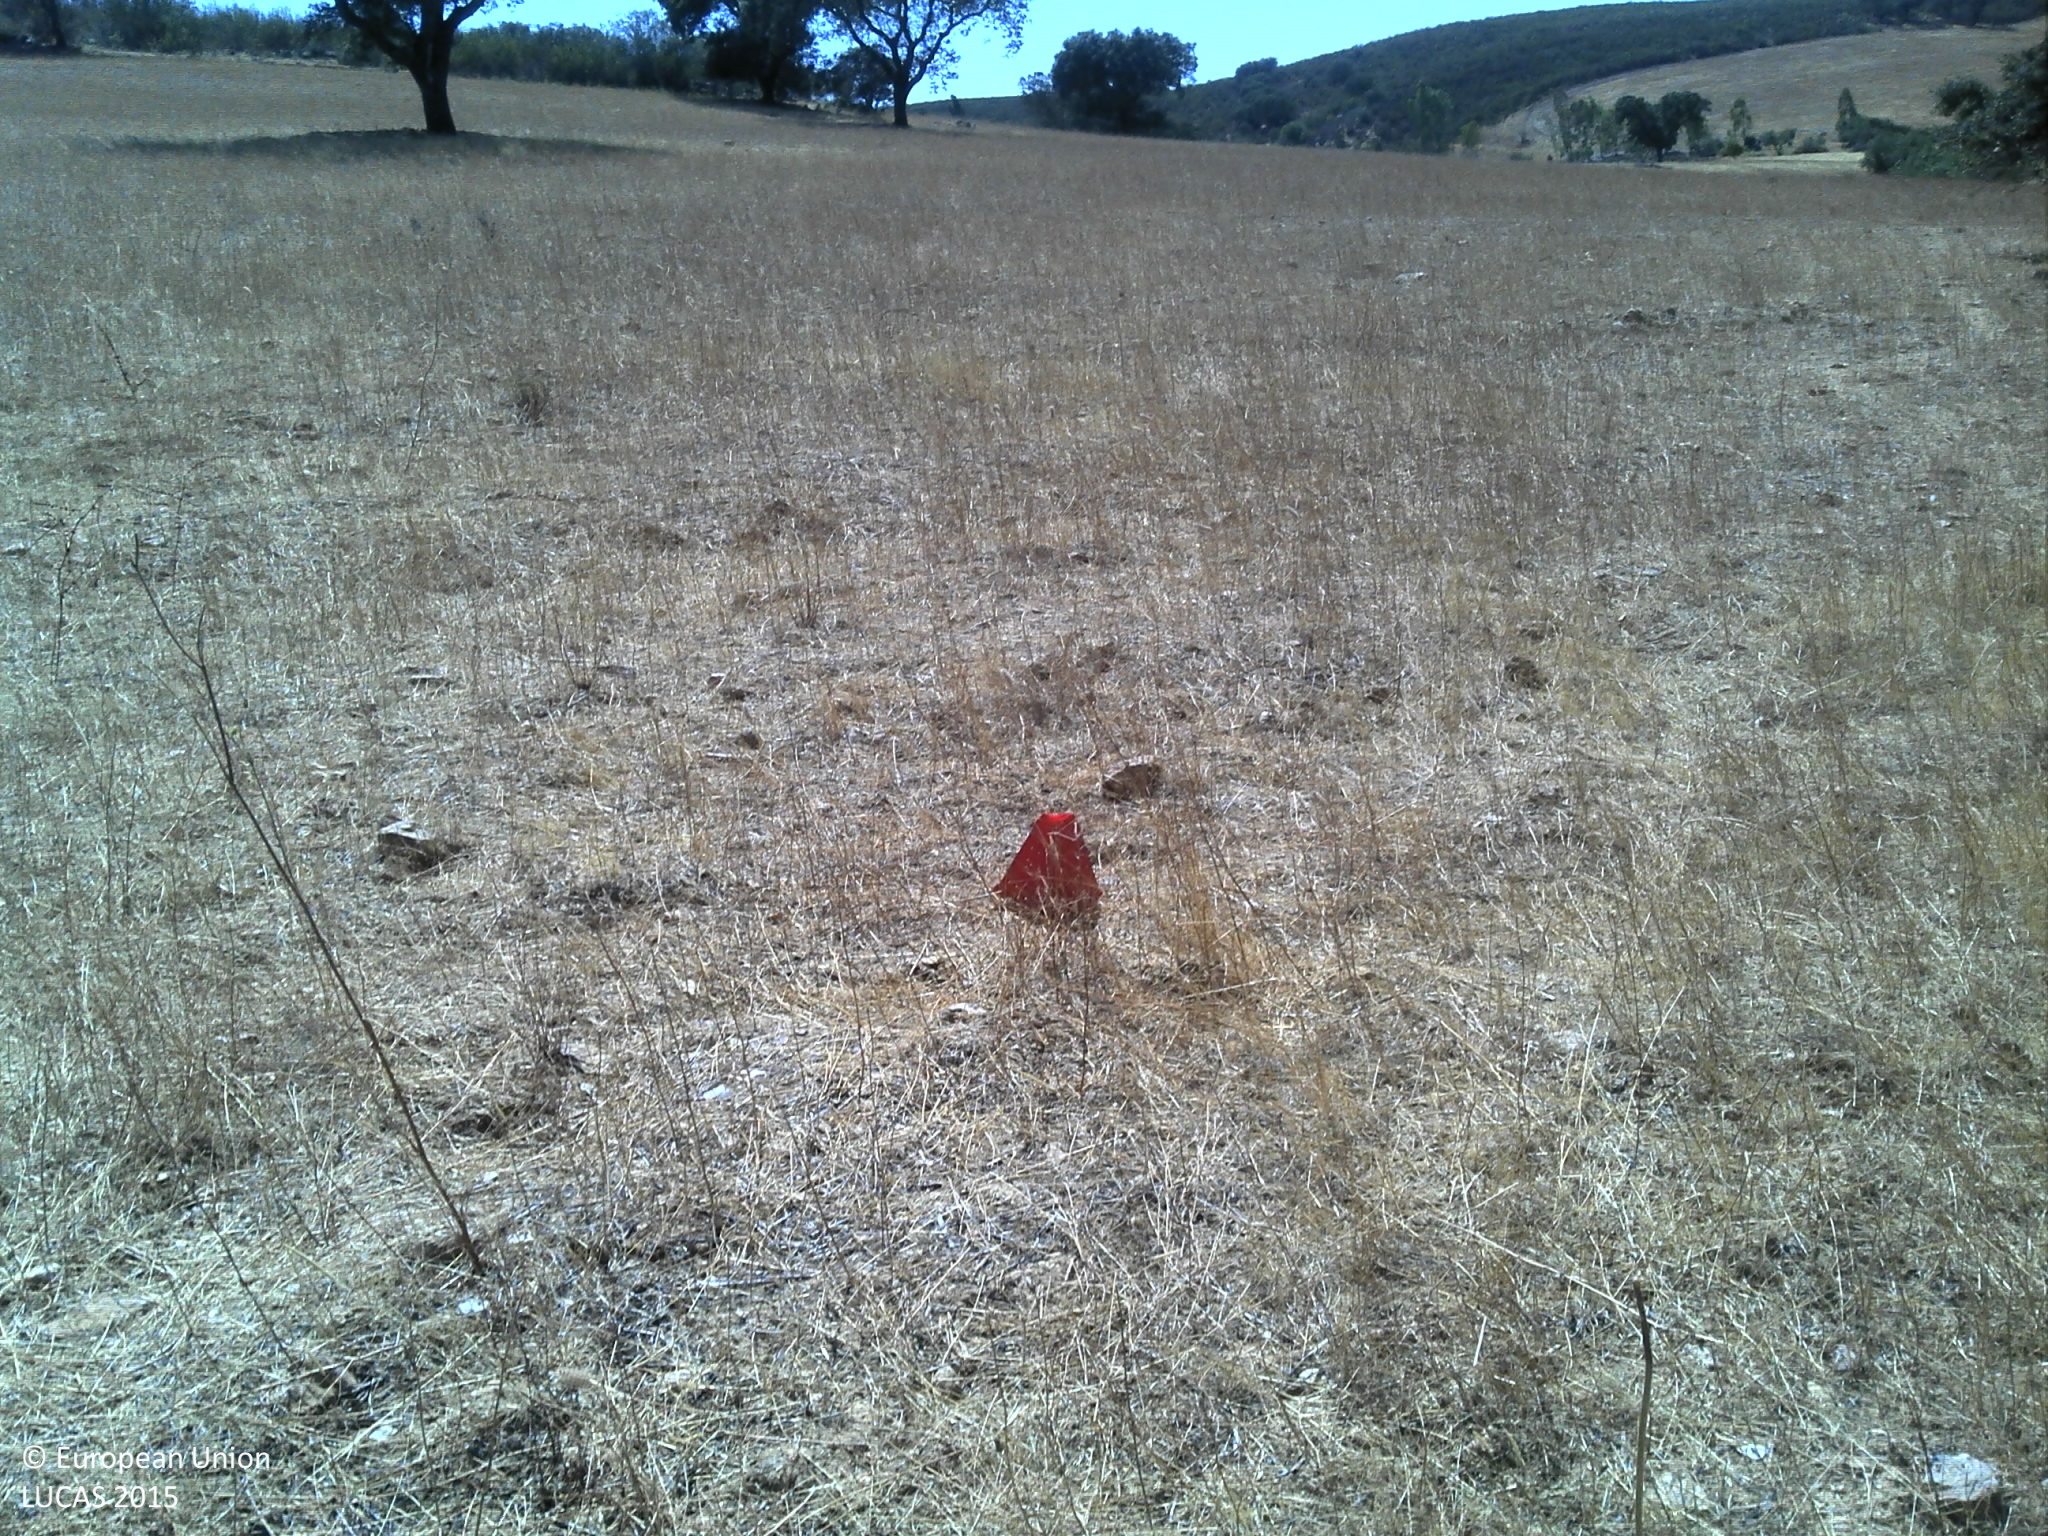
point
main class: Grassland
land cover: Grassland without tree/shrub cover
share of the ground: 10 - 25 %
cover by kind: unconsolidated bare surface 75 %, herbaceous plants 25 %
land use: Agriculture (excluding fallow land and kitchen gardens)
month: July
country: PT
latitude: 37.7863
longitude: -7.9316
